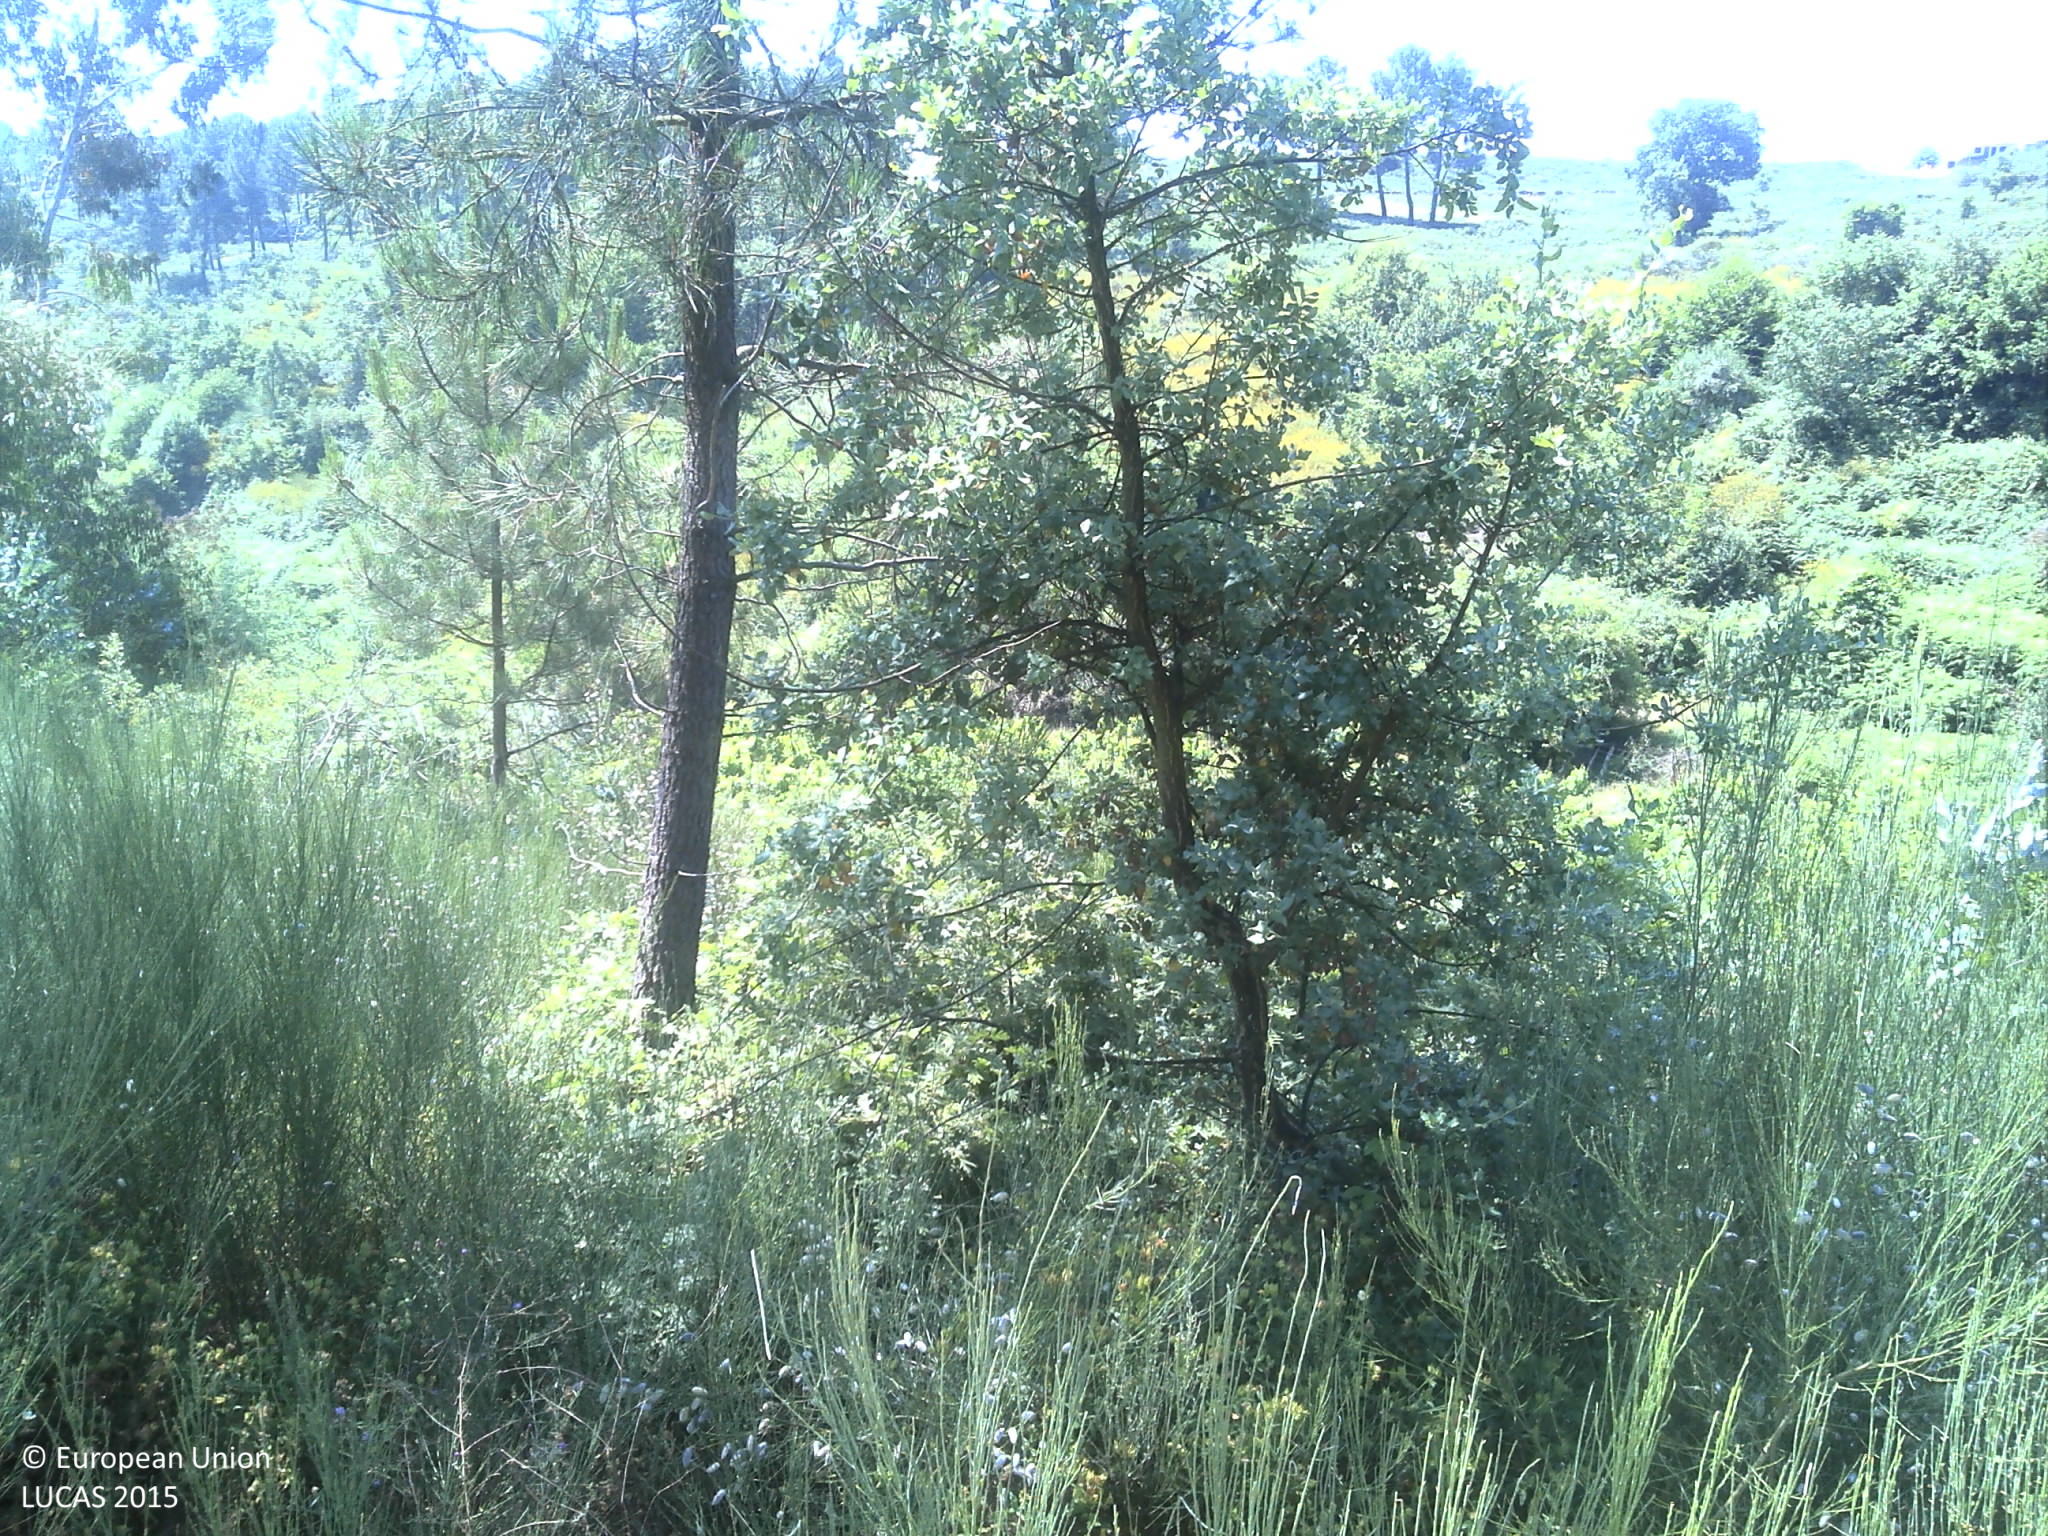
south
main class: Shrubland
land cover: Shrubland without tree cover
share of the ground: > 75 %
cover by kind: shrubs 85 %, herbaceous plants 10 %, unconsolidated bare surface 5 %
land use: Forestry
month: June
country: PT
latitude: 41.1420
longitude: -7.9695
